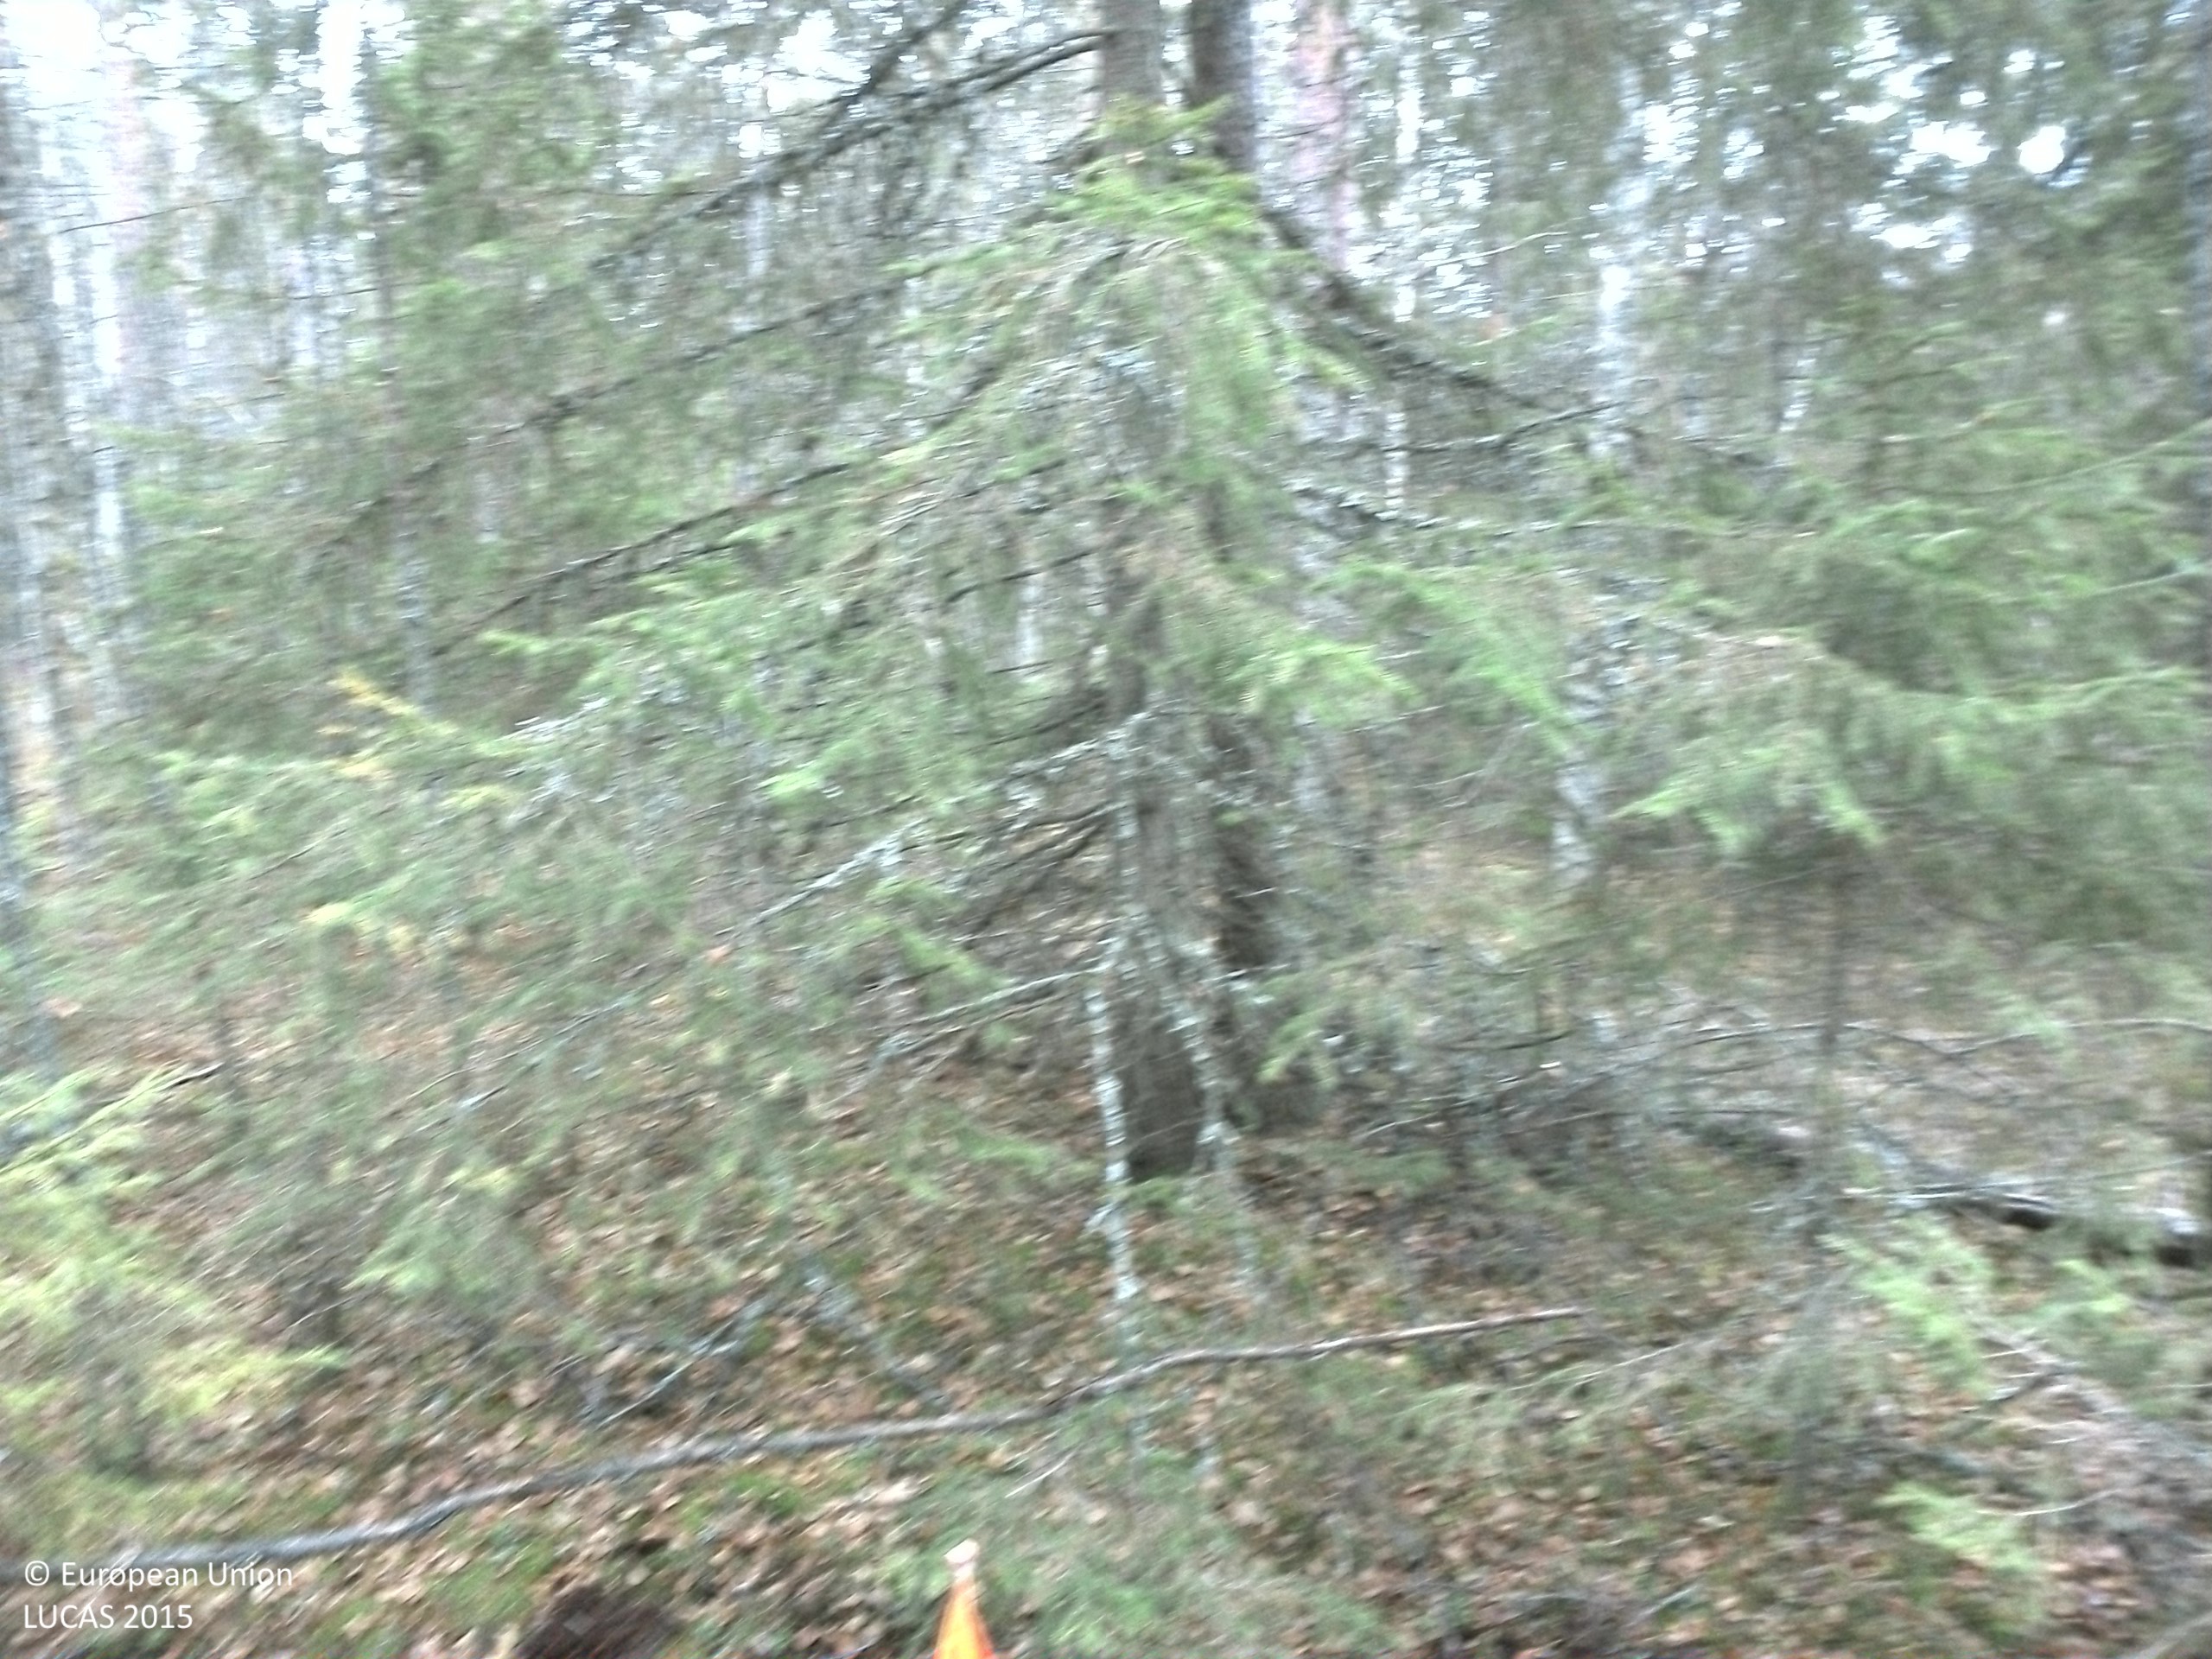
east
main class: Woodland
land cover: Spruce dominated mixed woodland
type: boreal forest
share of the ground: 50 - 75 %
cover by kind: coniferous forest trees 45 %, broadleaved forest trees 25 %, shrubs 10 %, herbaceous plants 10 %, lichens and mosses 10 %
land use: Forestry
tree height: > 5 m
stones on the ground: < 10 %
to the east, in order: Spruce dominated mixed woodland; Pine dominated mixed woodland; Pine dominated coniferous woodland; Electric lines; Spruce dominated mixed woodland; Fences; Spruce dominated mixed woodland; Fences; Spruce dominated coniferous woodland; Pine dominated mixed woodland; Tracks; Spruce dominated mixed woodland; Broadleaved woodland; Artificial constructions in urban areas; Electric lines; Artificial constructions in urban areas; Grass margins
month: November
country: SE
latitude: 57.5946
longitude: 14.7638
